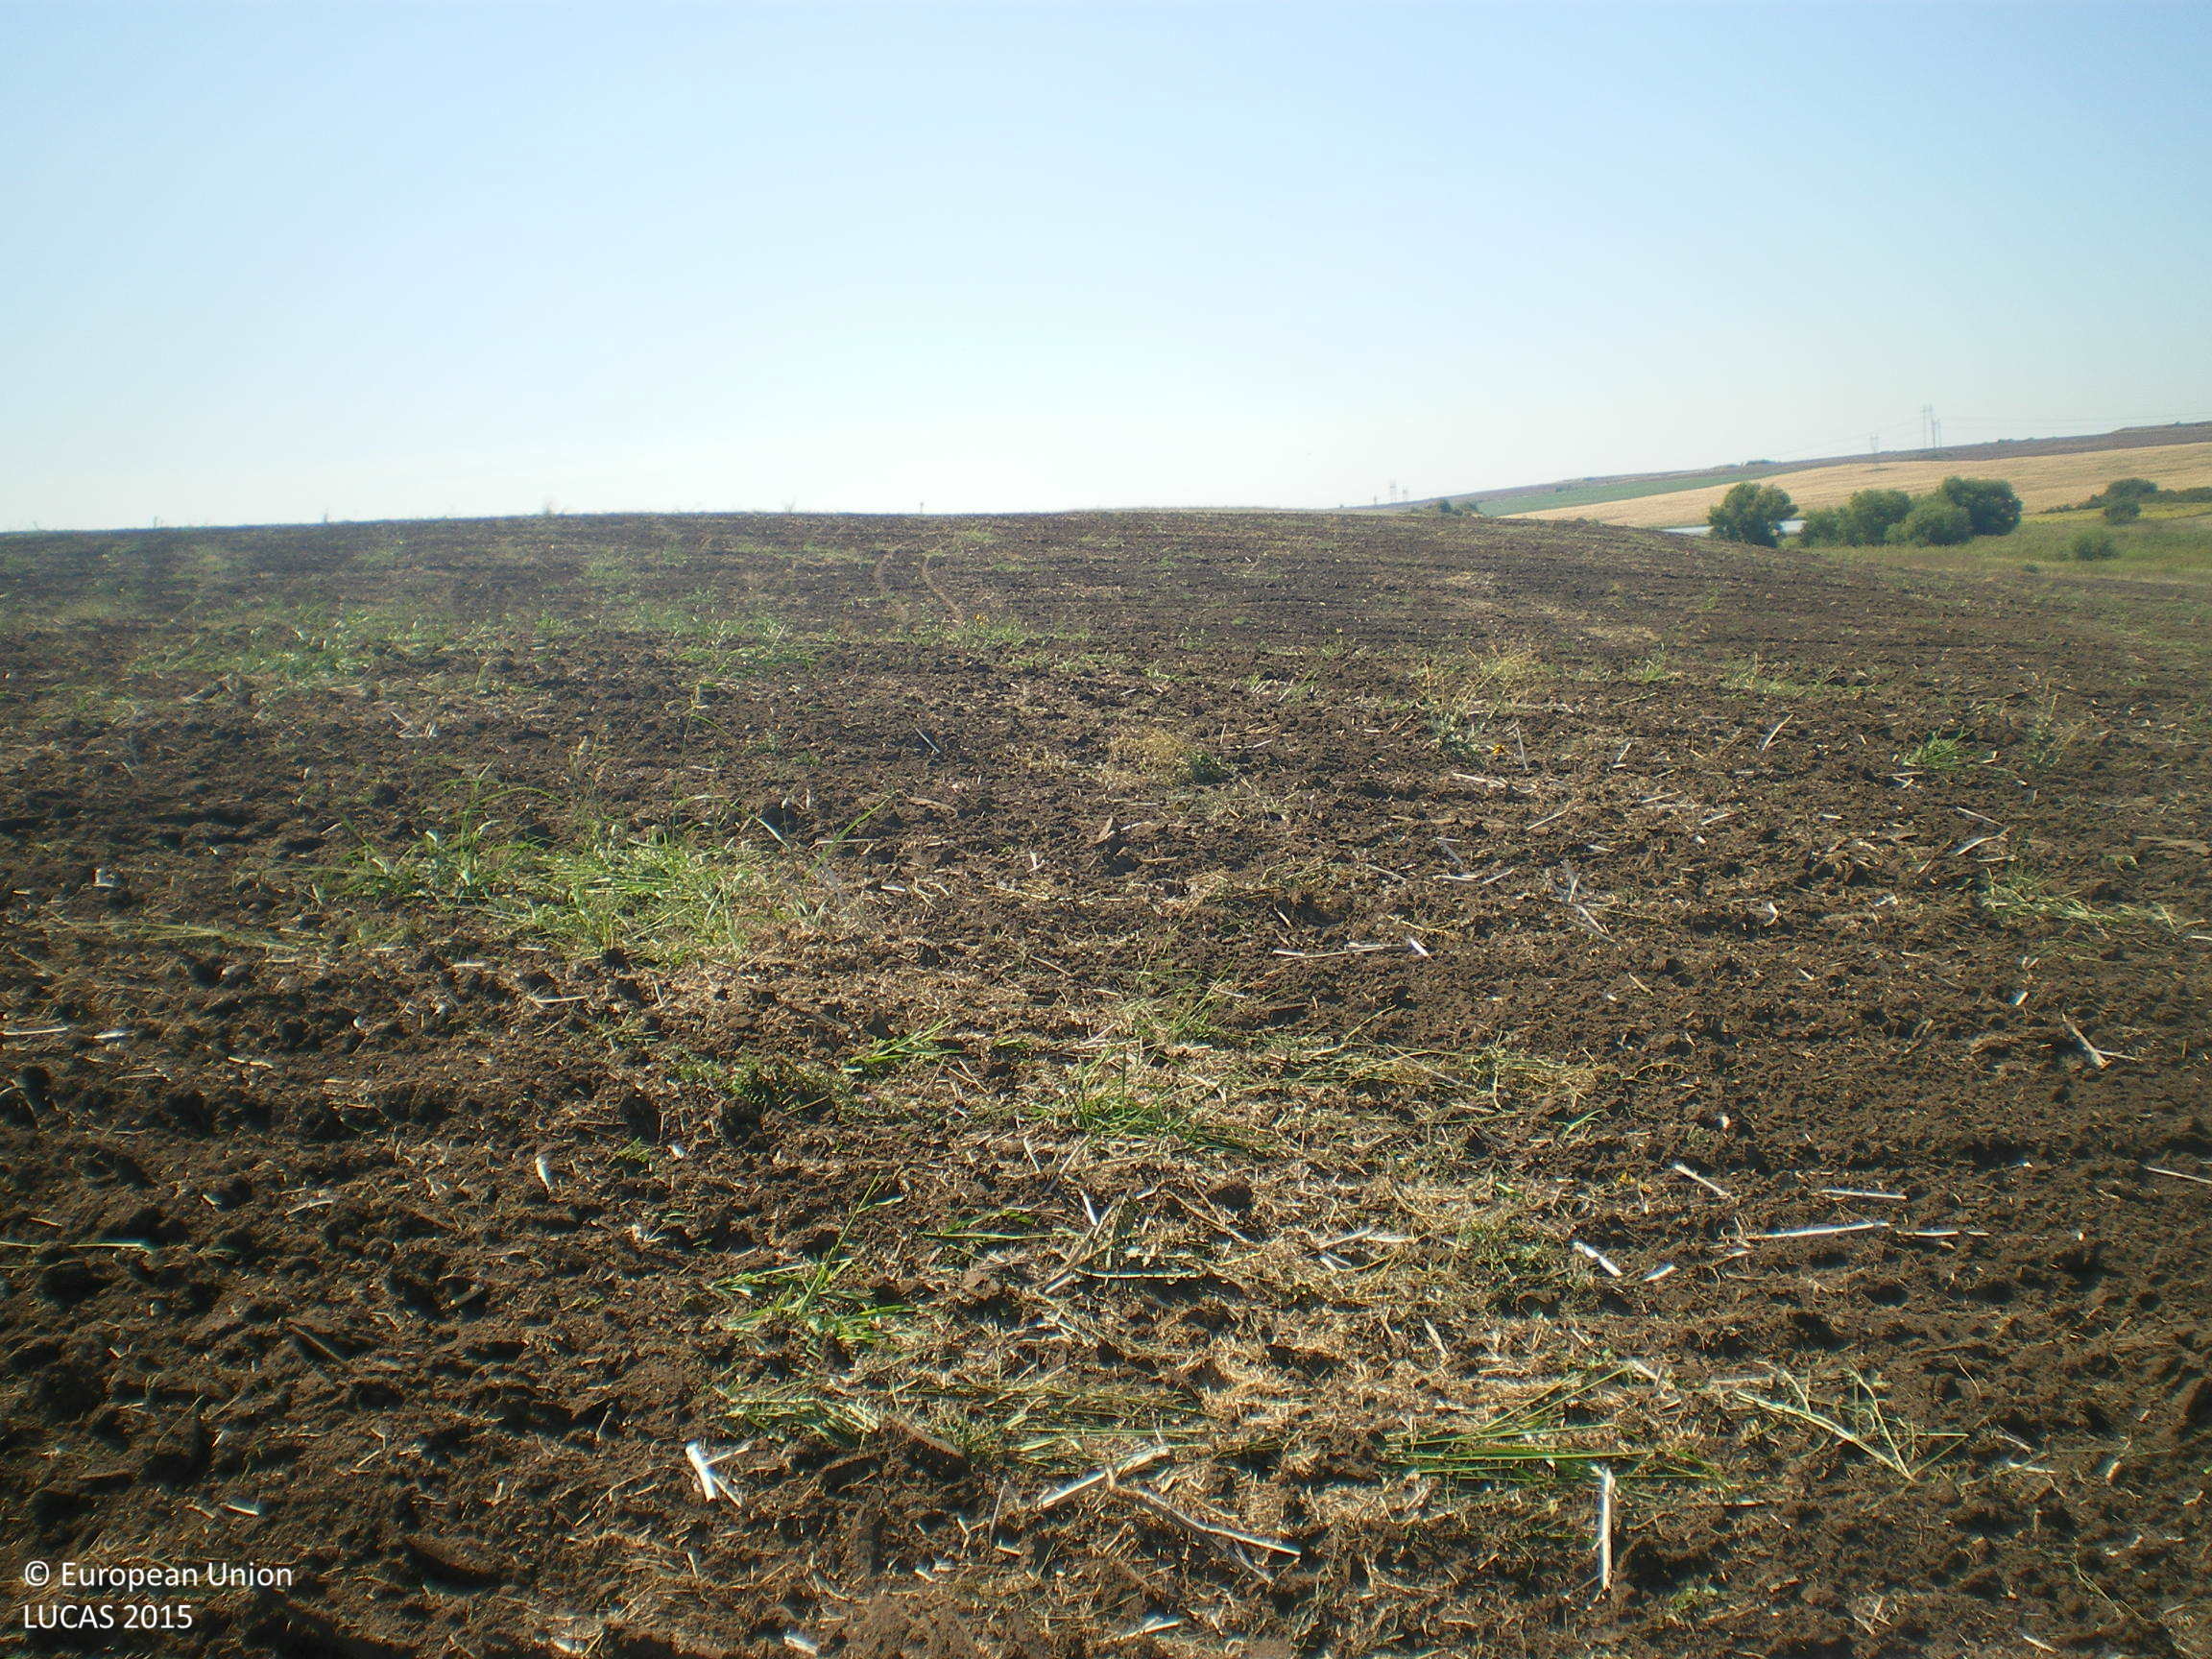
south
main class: Cropland
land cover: Rape and turnip rape
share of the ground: < 10 %
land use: Agriculture (excluding fallow land and kitchen gardens)
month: August
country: BG
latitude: 42.1423
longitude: 25.6658
